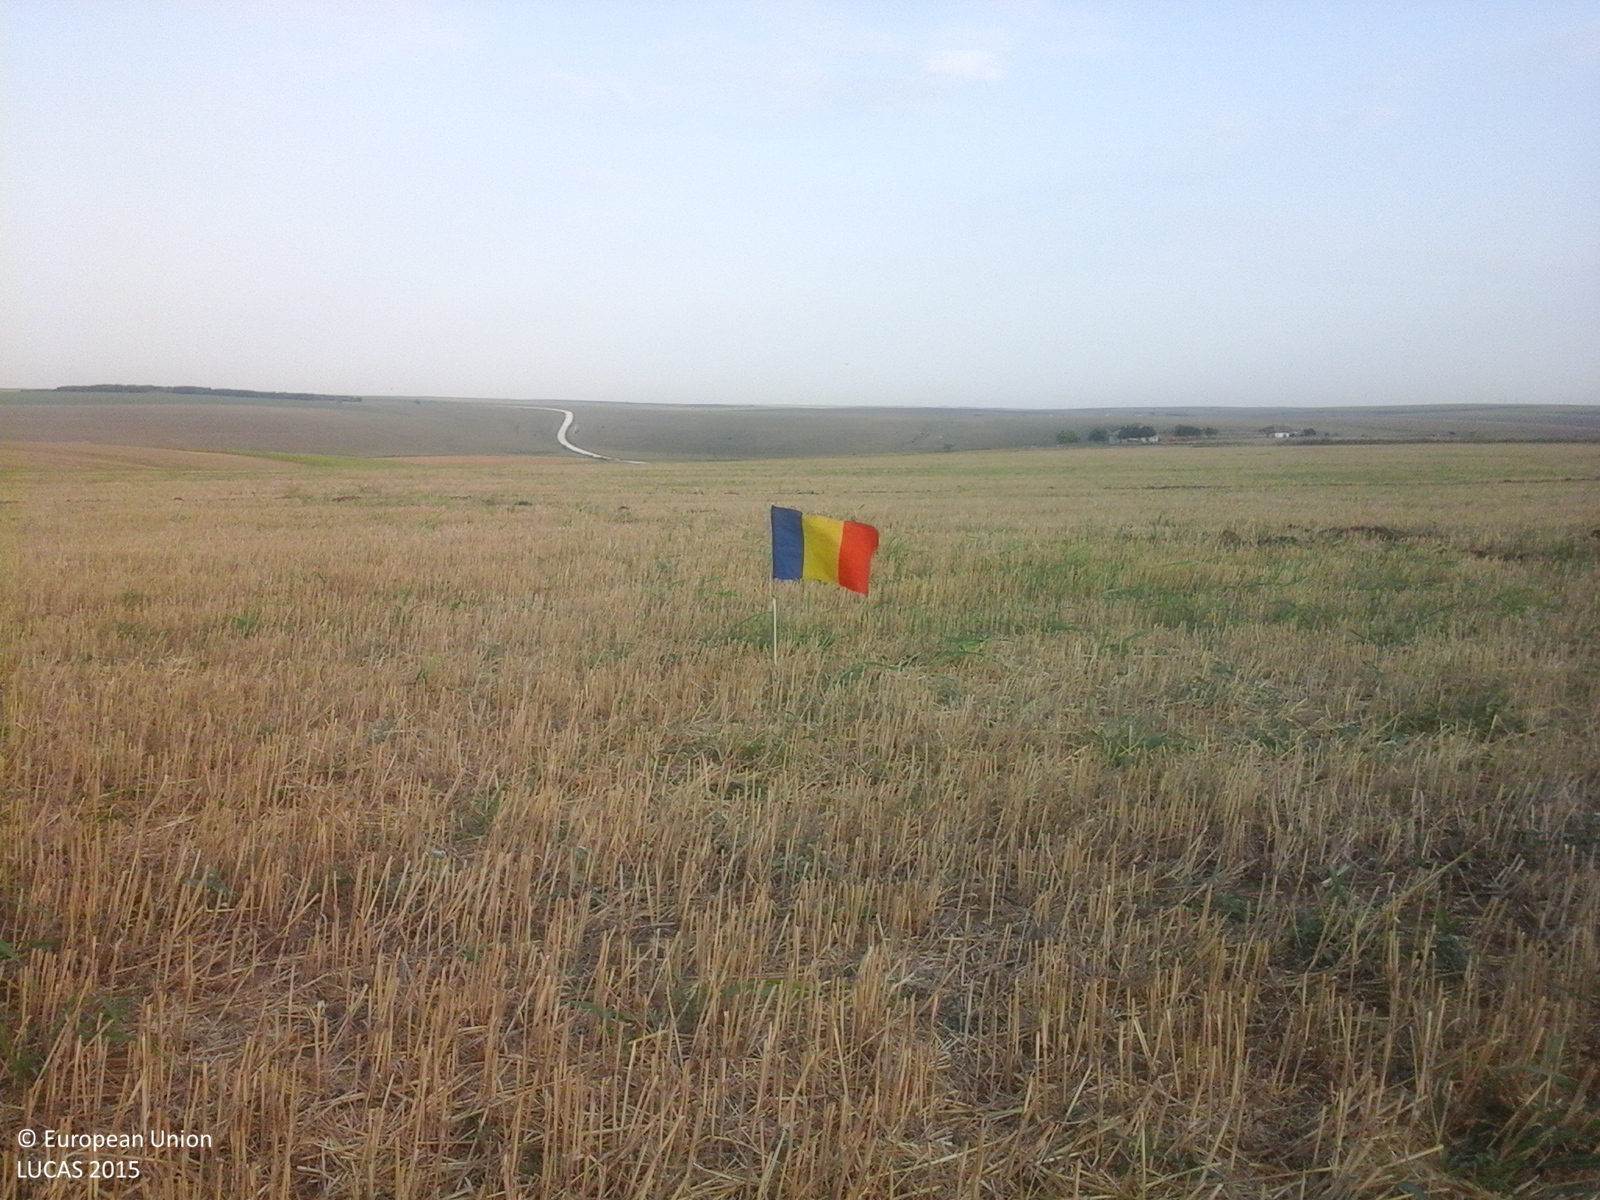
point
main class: Cropland
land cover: Common wheat
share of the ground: > 75 %
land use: Agriculture (excluding fallow land and kitchen gardens)
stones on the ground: < 10 %
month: August
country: RO
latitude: 44.0059
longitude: 28.1539
